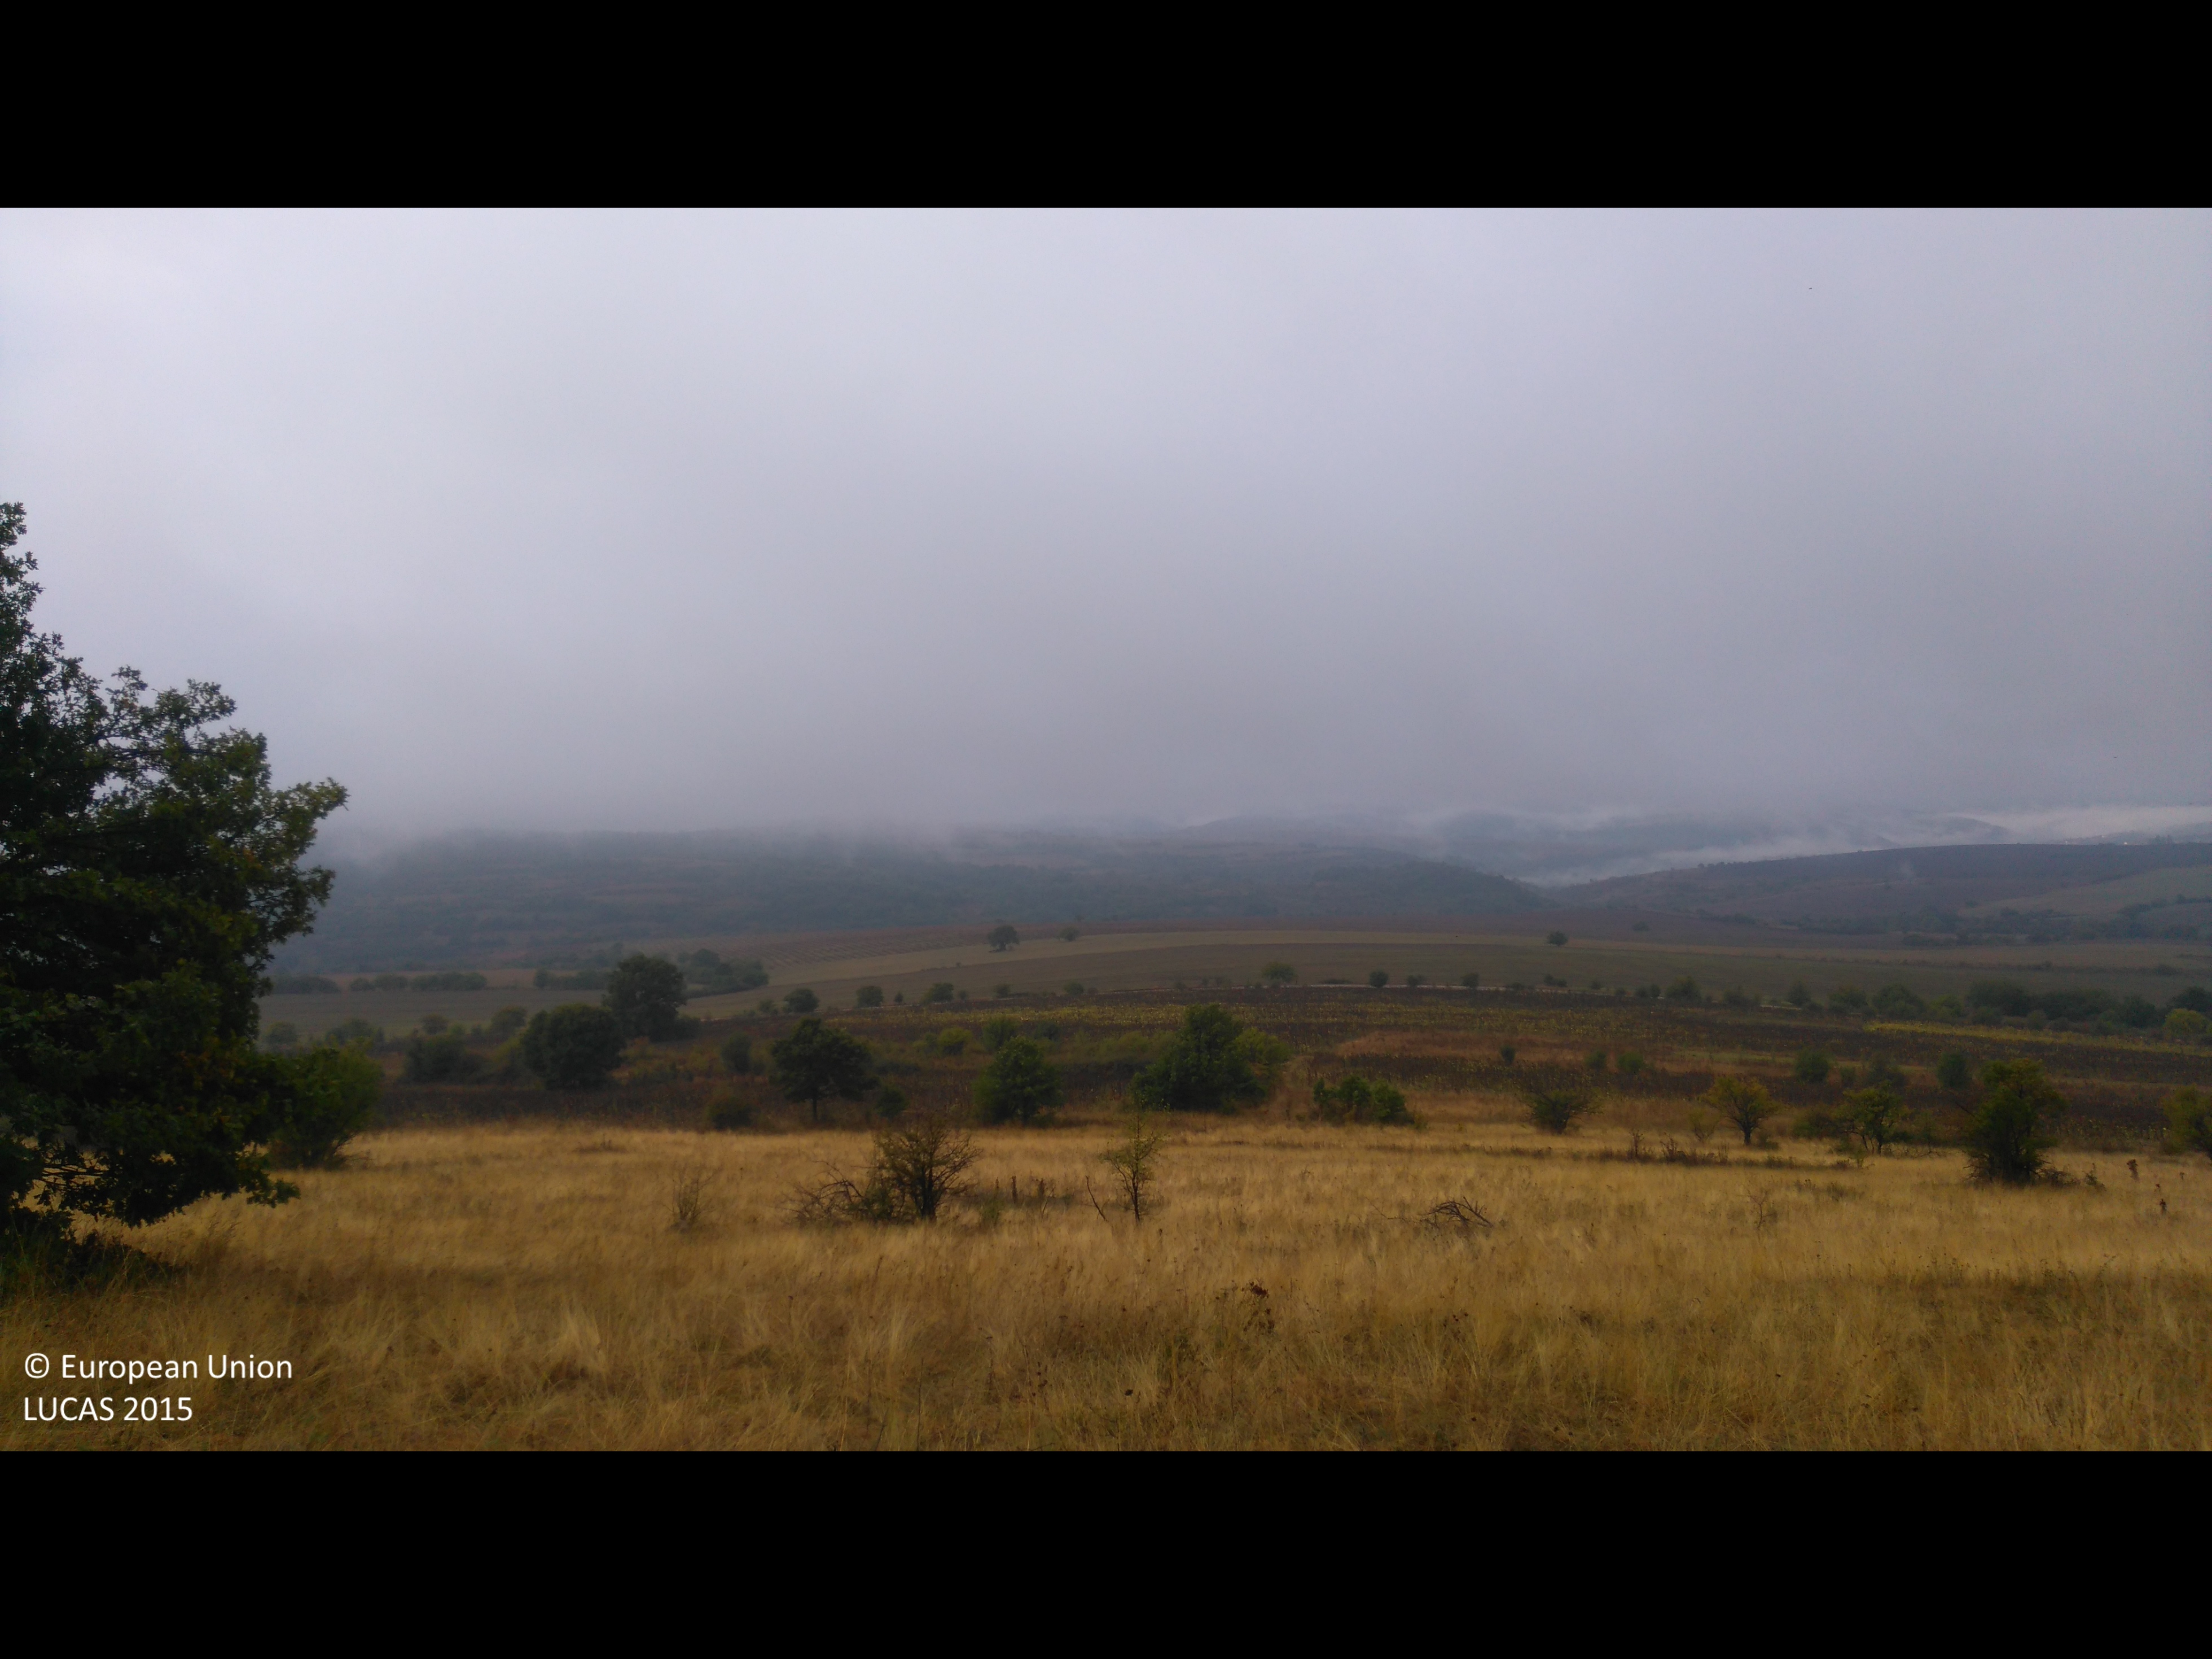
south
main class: Grassland
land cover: Grassland with sparse tree/shrub cover
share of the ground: > 75 %
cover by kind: herbaceous plants 90 %, broadleaved forest trees 5 %, shrubs 5 %
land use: Agriculture (excluding fallow land and kitchen gardens)
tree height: > 5 m
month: October
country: BG
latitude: 42.6504
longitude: 23.8373
